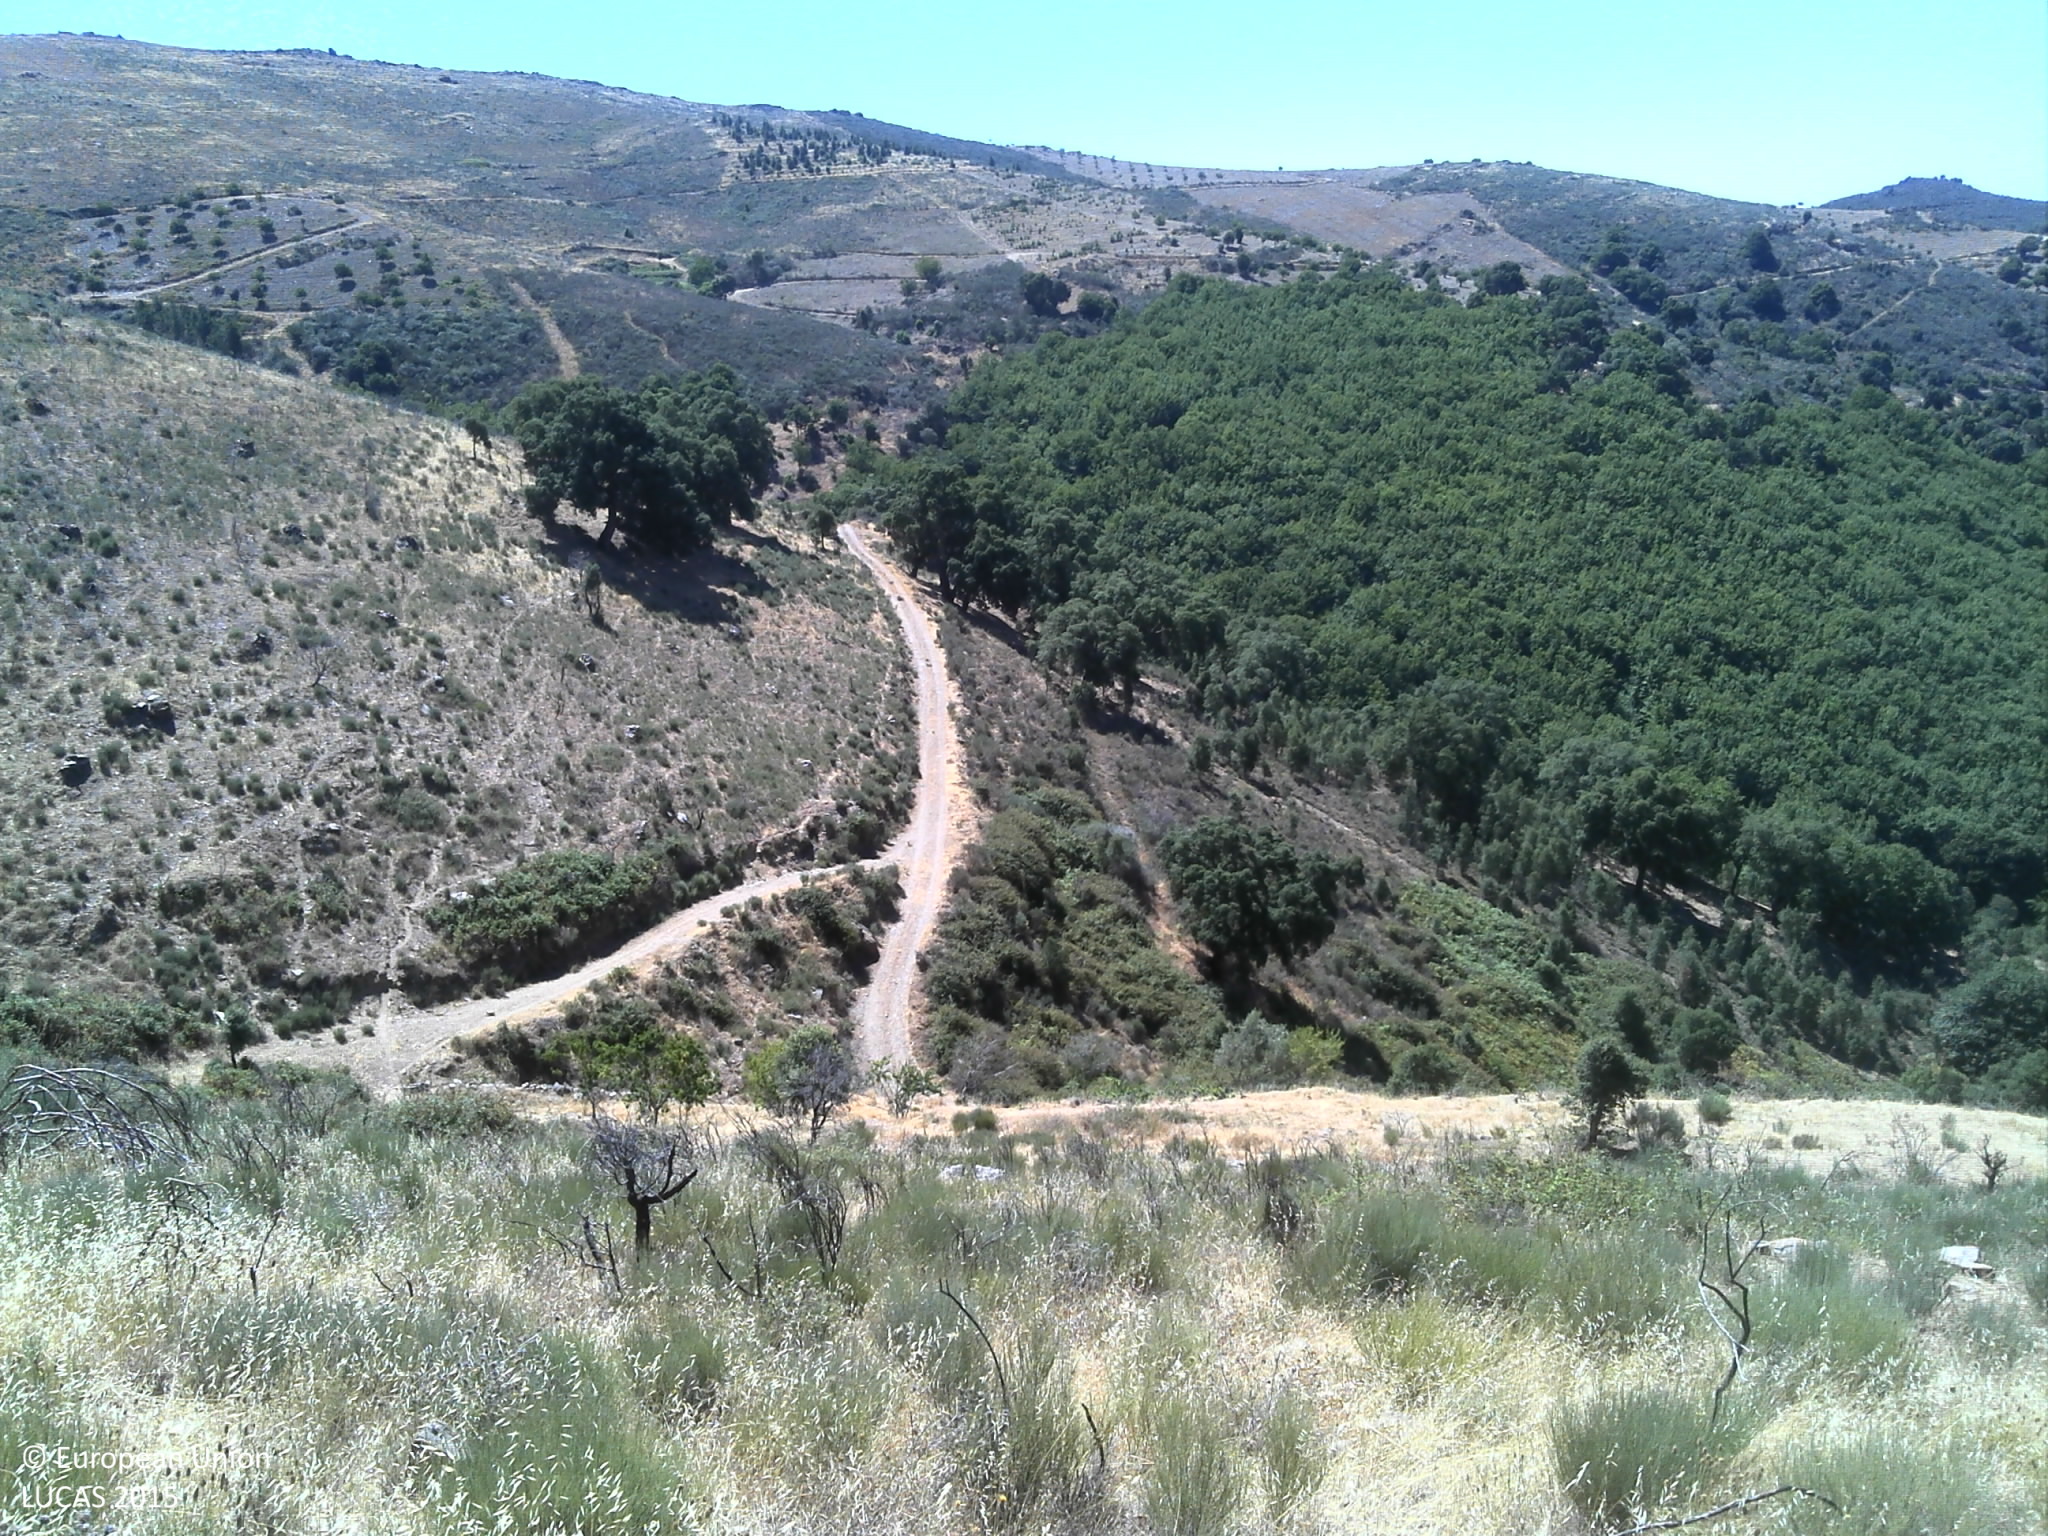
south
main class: Shrubland
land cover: Shrubland without tree cover
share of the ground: > 75 %
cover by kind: shrubs 75 %, unconsolidated bare surface 15 %, herbaceous plants 10 %
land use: Abandoned areas
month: July
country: PT
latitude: 41.4219
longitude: -7.0206
